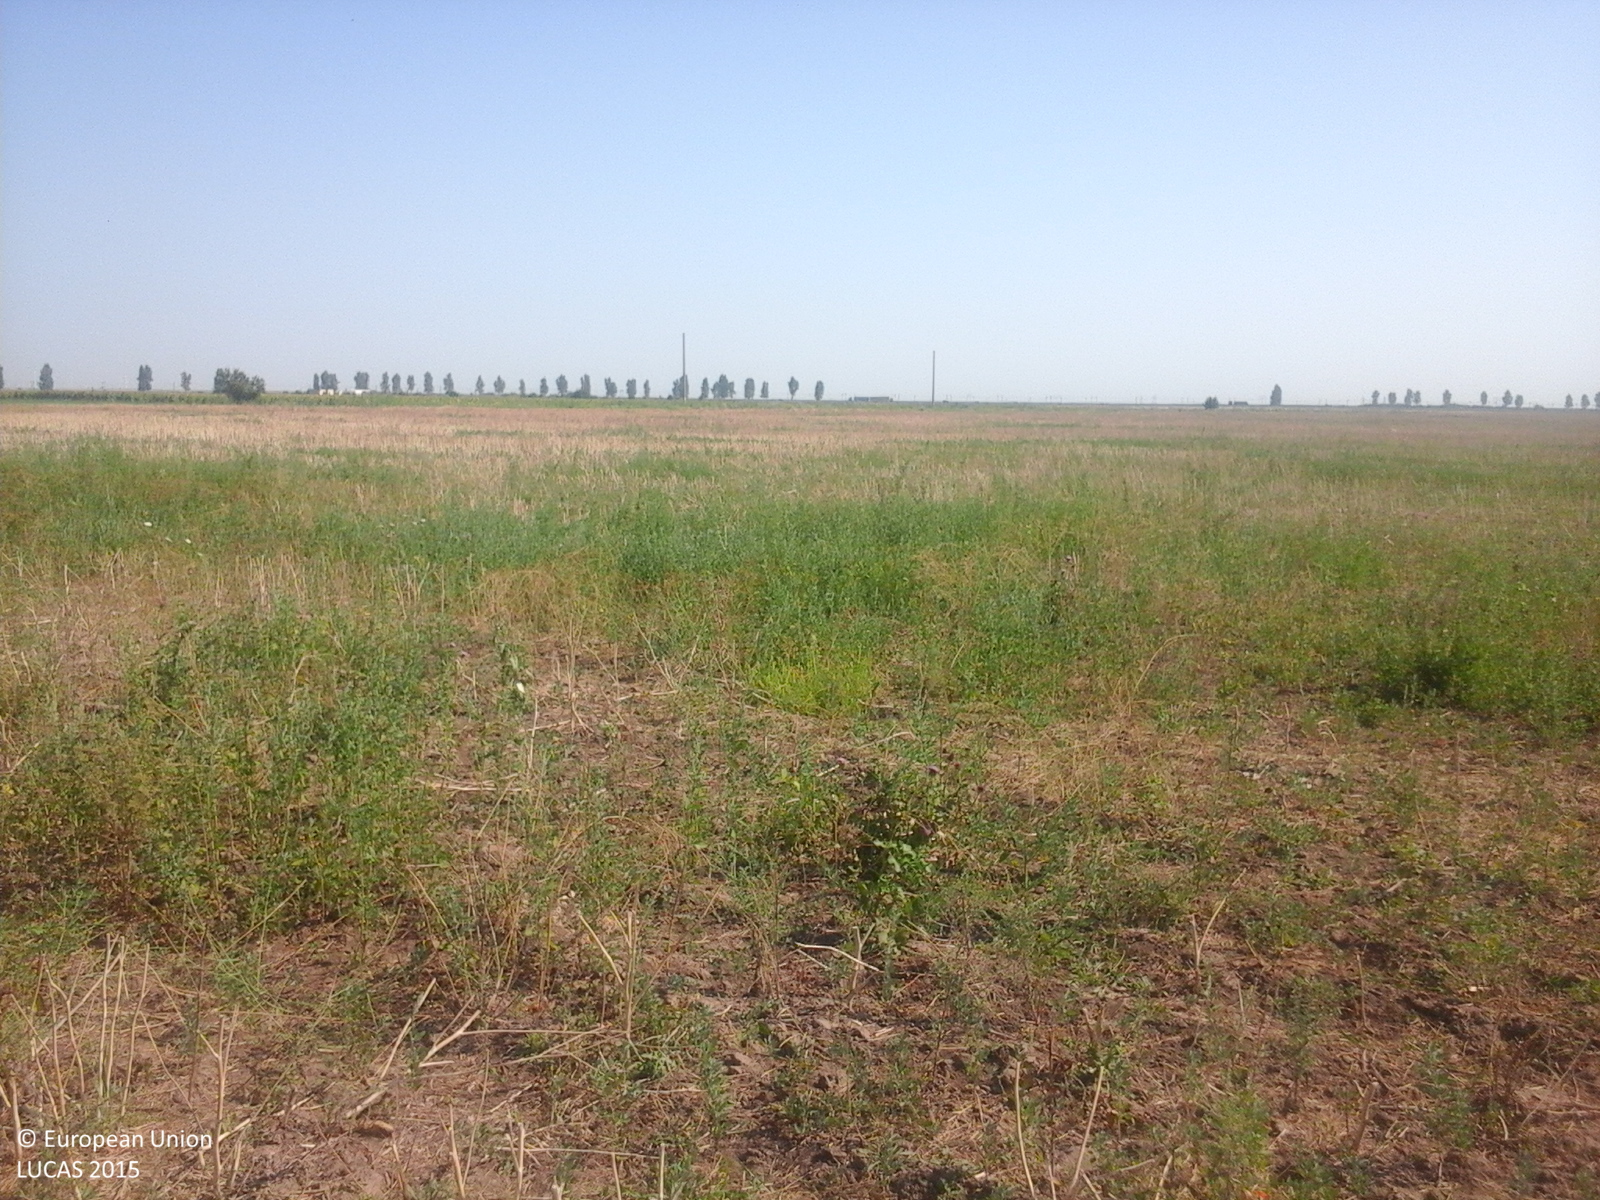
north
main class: Cropland
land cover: Rape and turnip rape
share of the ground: 10 - 25 %
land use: Agriculture (excluding fallow land and kitchen gardens)
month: July
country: RO
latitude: 44.4059
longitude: 27.7669
